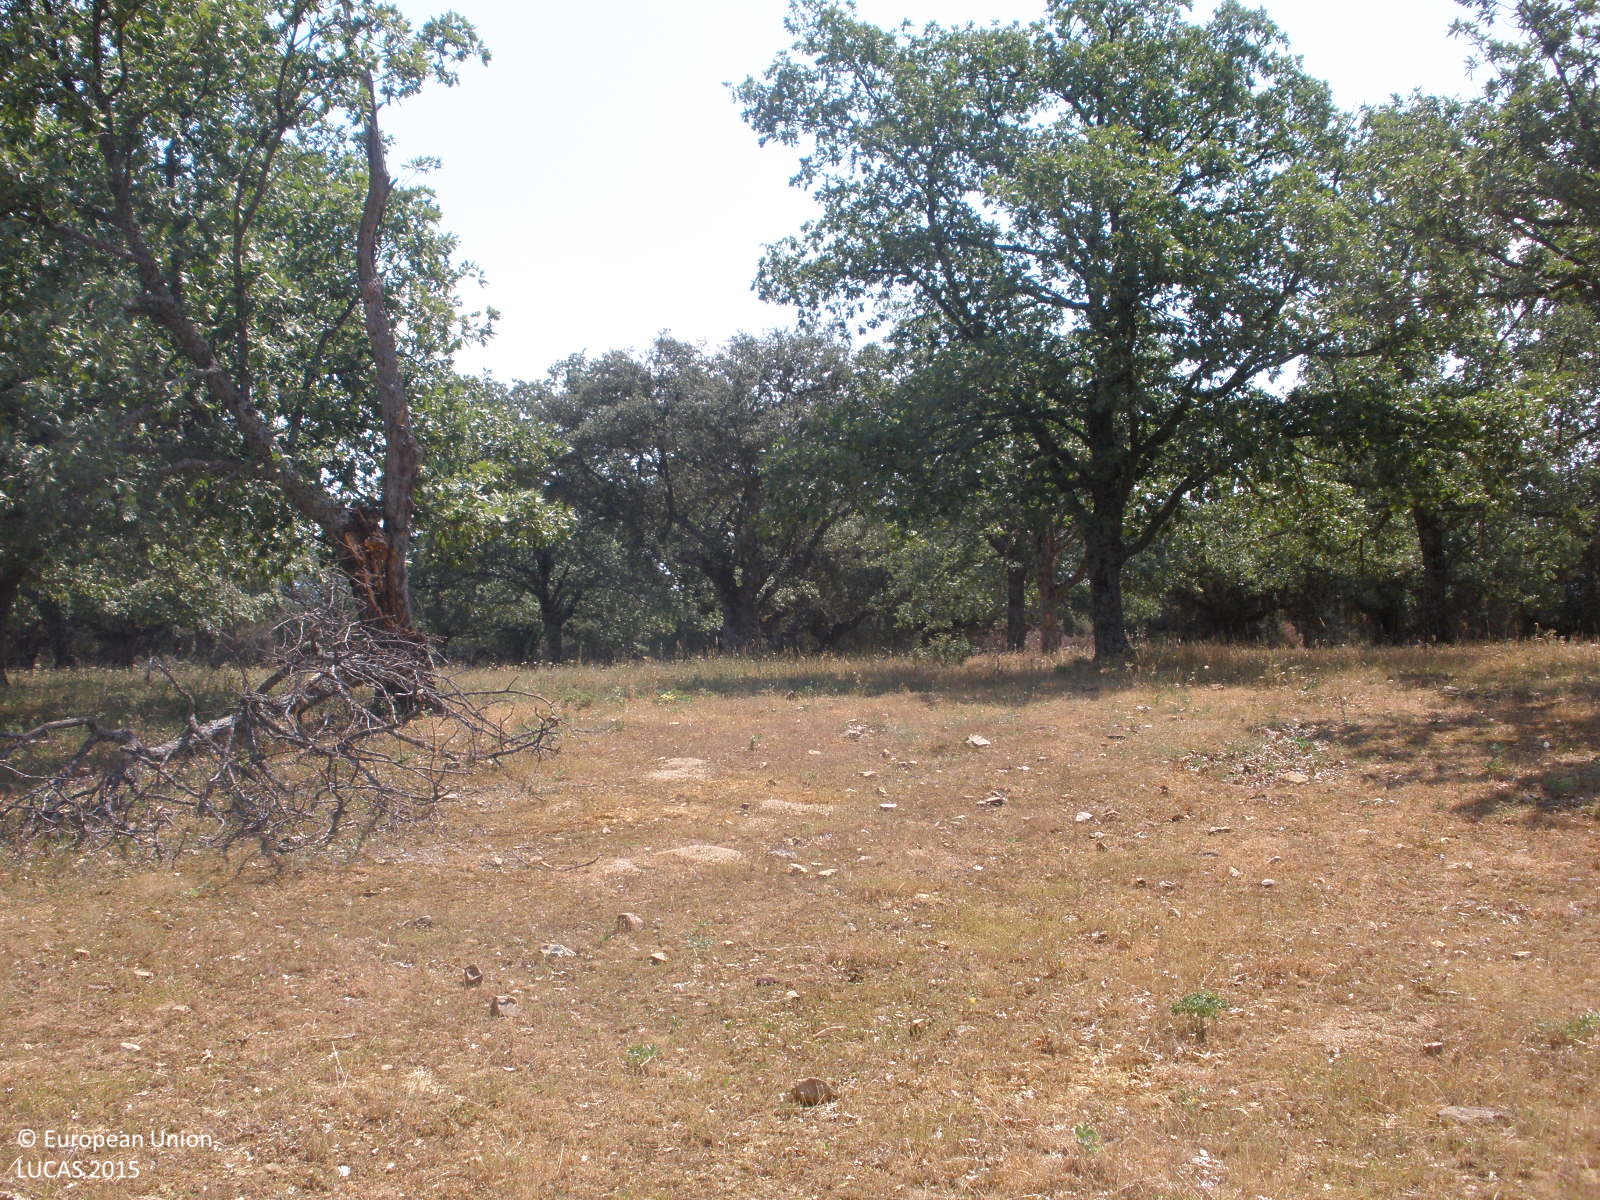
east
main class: Woodland
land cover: Broadleaved woodland
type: broadleaved evergreen forest
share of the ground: 25 - 50 %
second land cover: Grassland without tree/shrub cover
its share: > 75 %
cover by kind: herbaceous plants 80 %, broadleaved forest trees 20 %
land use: Forestry
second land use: Agriculture (excluding fallow land and kitchen gardens)
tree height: > 5 m
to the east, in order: Broadleaved woodland; Grassland without tree/shrub cover
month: June
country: ES
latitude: 40.6424
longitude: -6.0798
